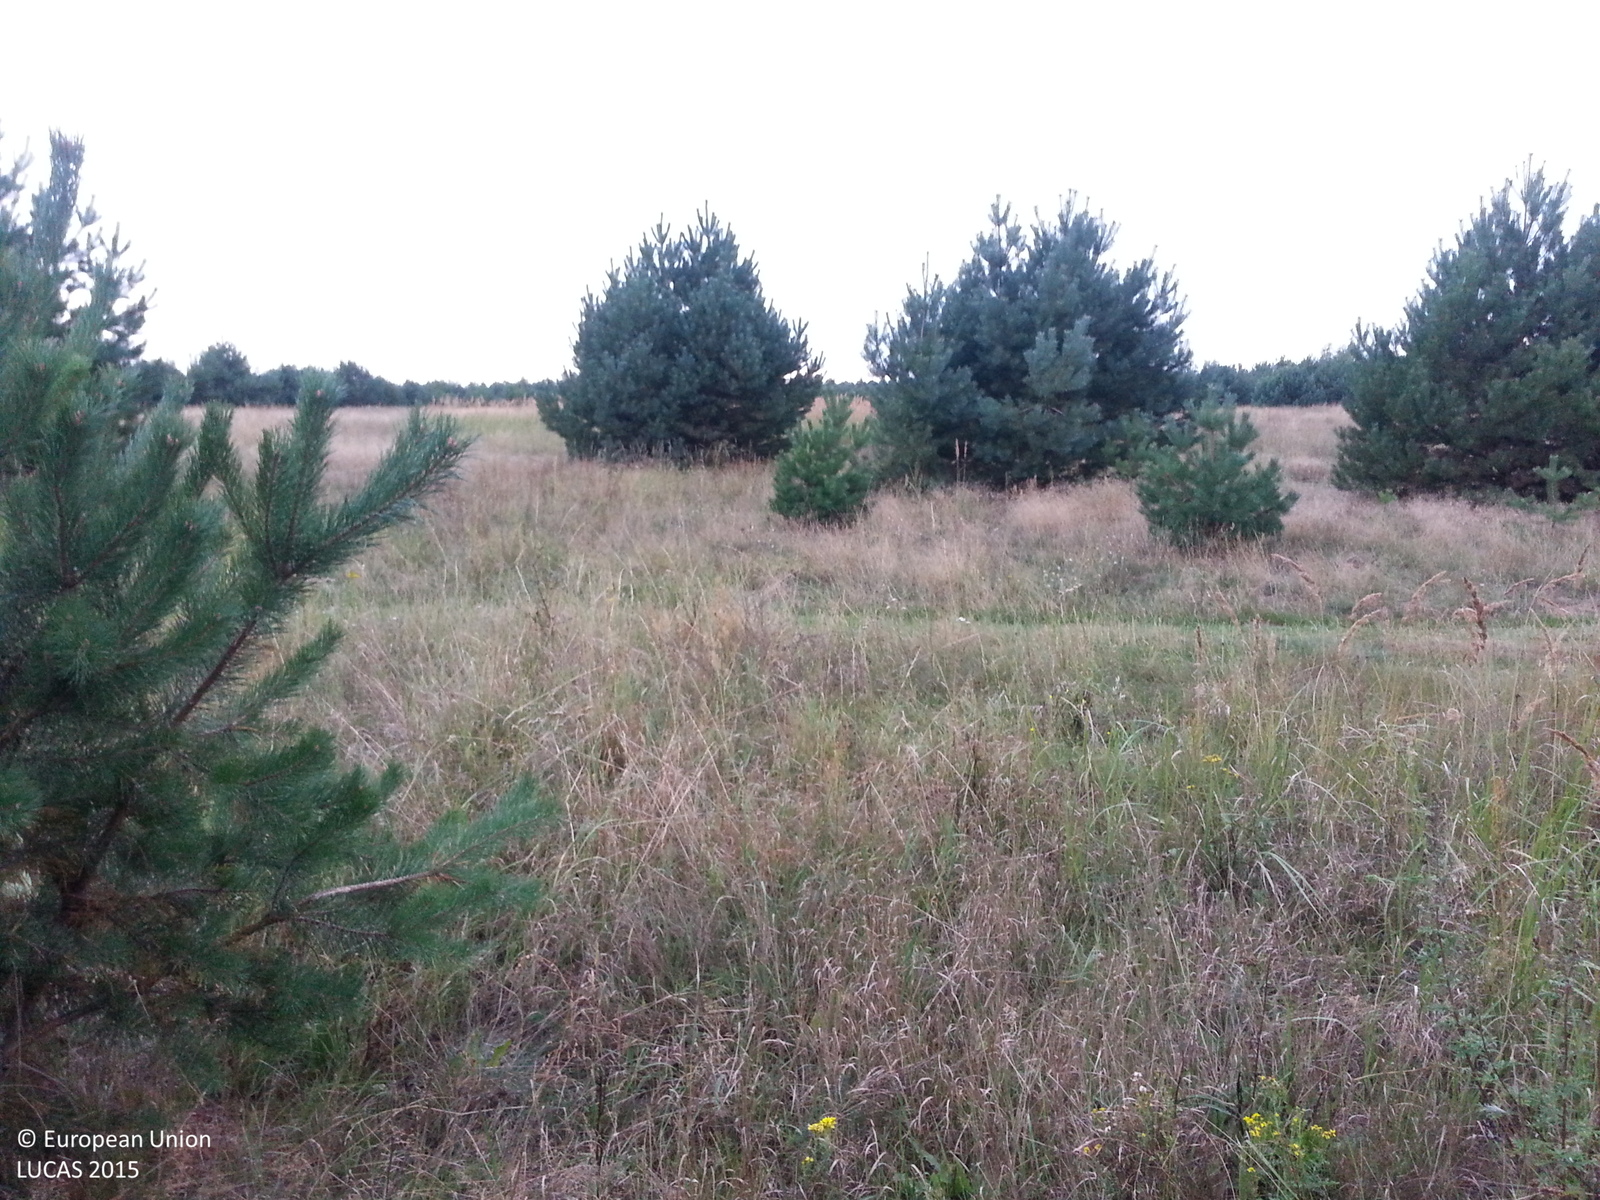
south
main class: Grassland
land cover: Grassland with sparse tree/shrub cover
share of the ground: > 75 %
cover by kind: herbaceous plants 90 %, coniferous forest trees 5 %, shrubs 5 %
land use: Semi-natural and natural areas not in use
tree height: < 5 m
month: September
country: PL
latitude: 53.1639
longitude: 18.1378
